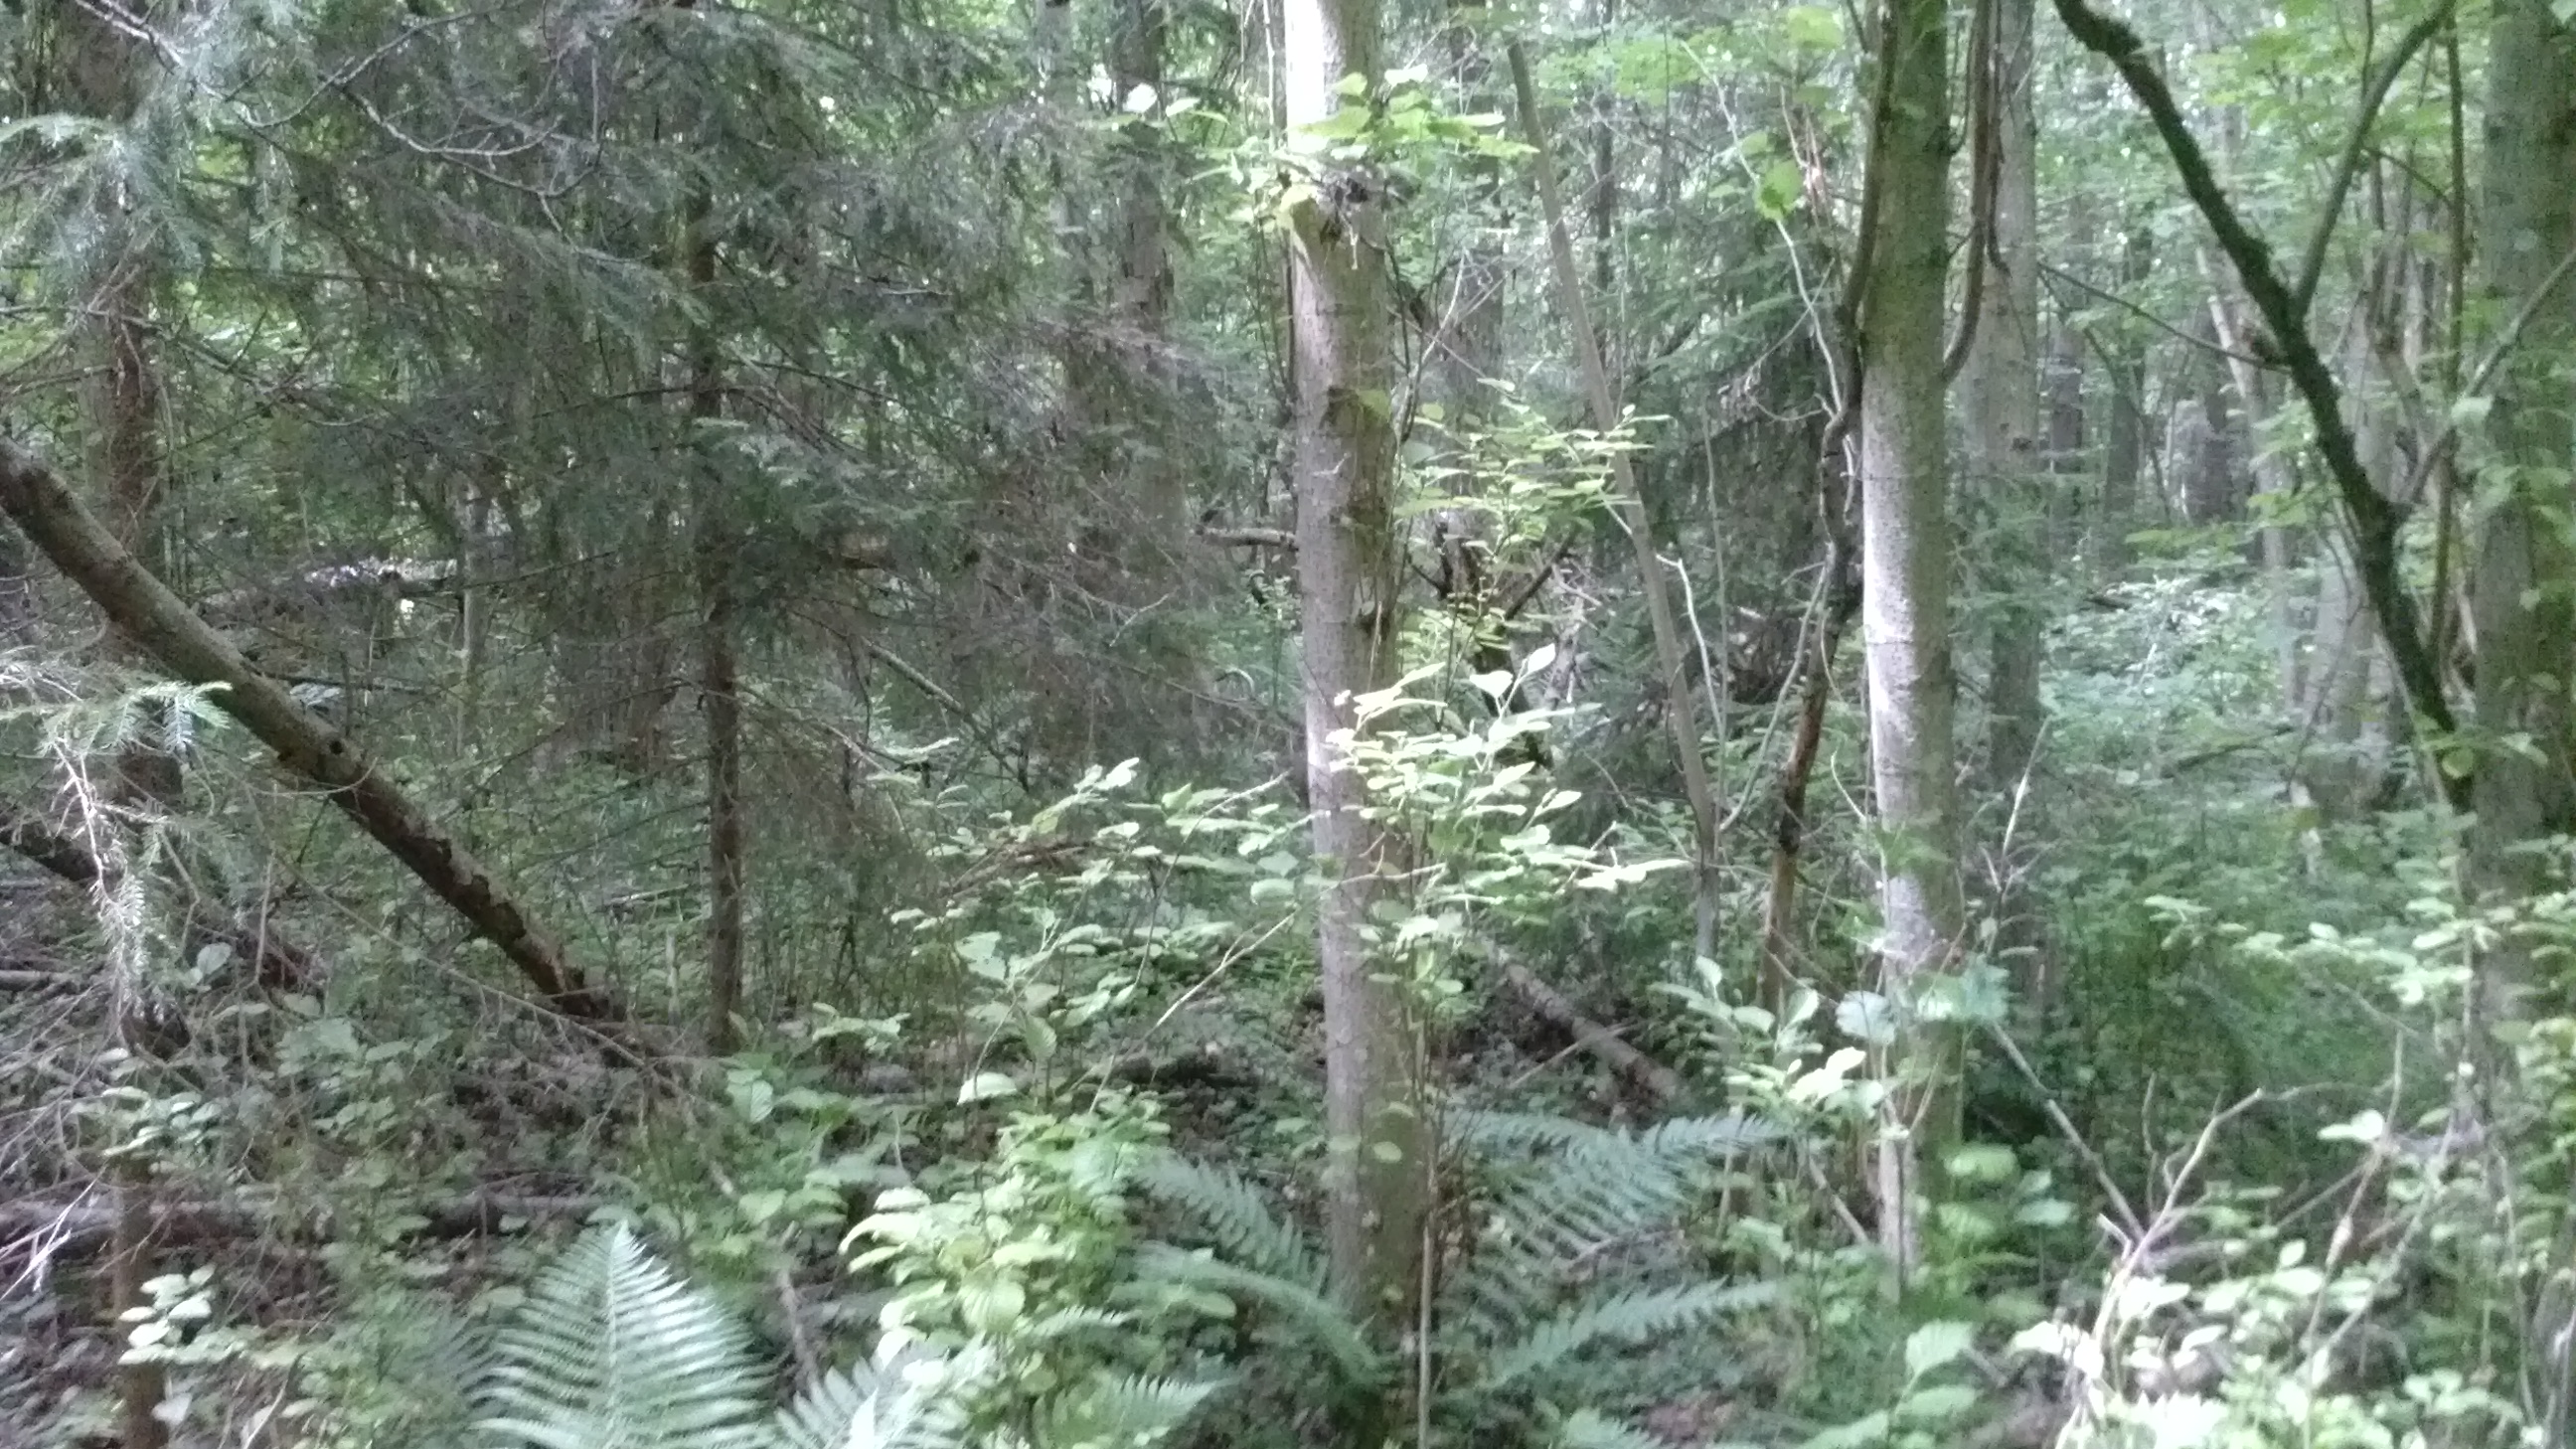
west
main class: Woodland
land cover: Spruce dominated mixed woodland
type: hemiboreal forest and nemoral coniferous forest and mixed broadleaved-coniferous forest
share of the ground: > 75 %
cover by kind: coniferous forest trees 55 %, broadleaved forest trees 30 %, herbaceous plants 10 %, shrubs 5 %
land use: Forestry
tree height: > 5 m
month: June
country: LV
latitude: 56.5784
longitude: 27.7524
